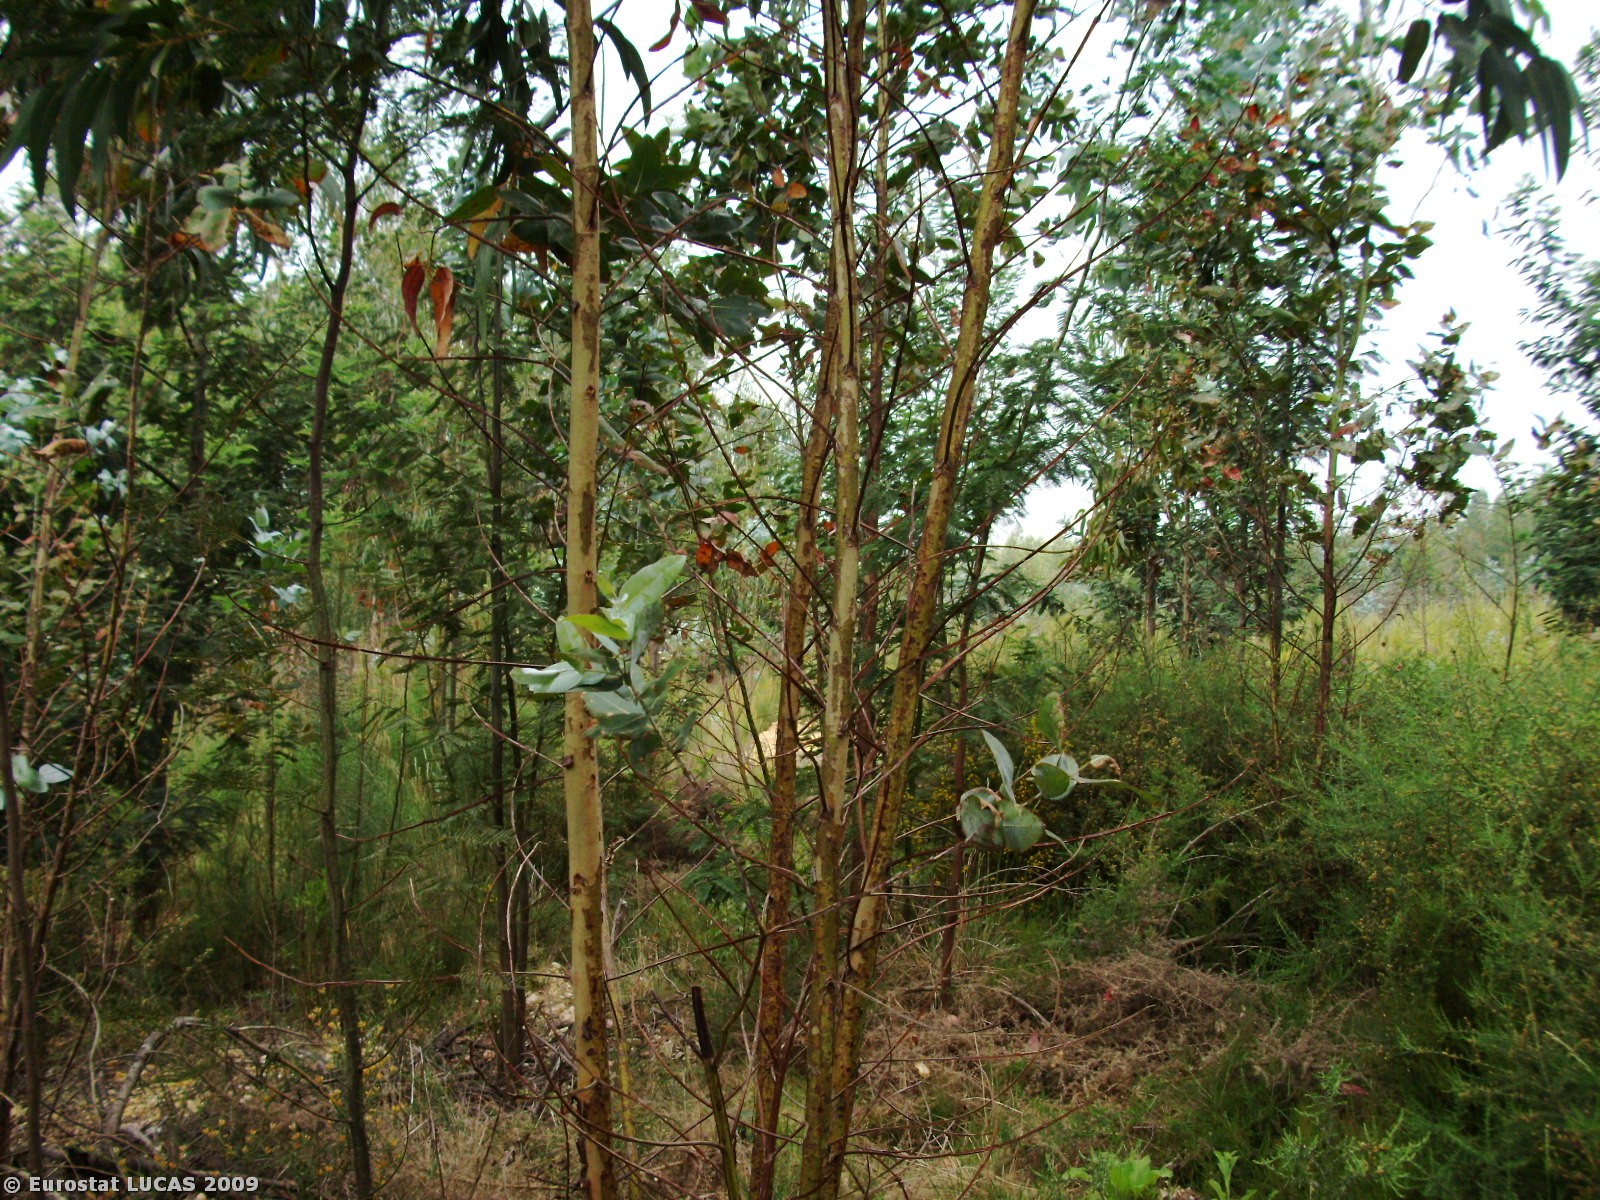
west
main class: Woodland
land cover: Broadleaved woodland
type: plantations and self-sown exotic forest
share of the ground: > 75 %
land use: Forestry
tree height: > 5 m
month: May
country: PT
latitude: 40.5134
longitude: -8.3687
